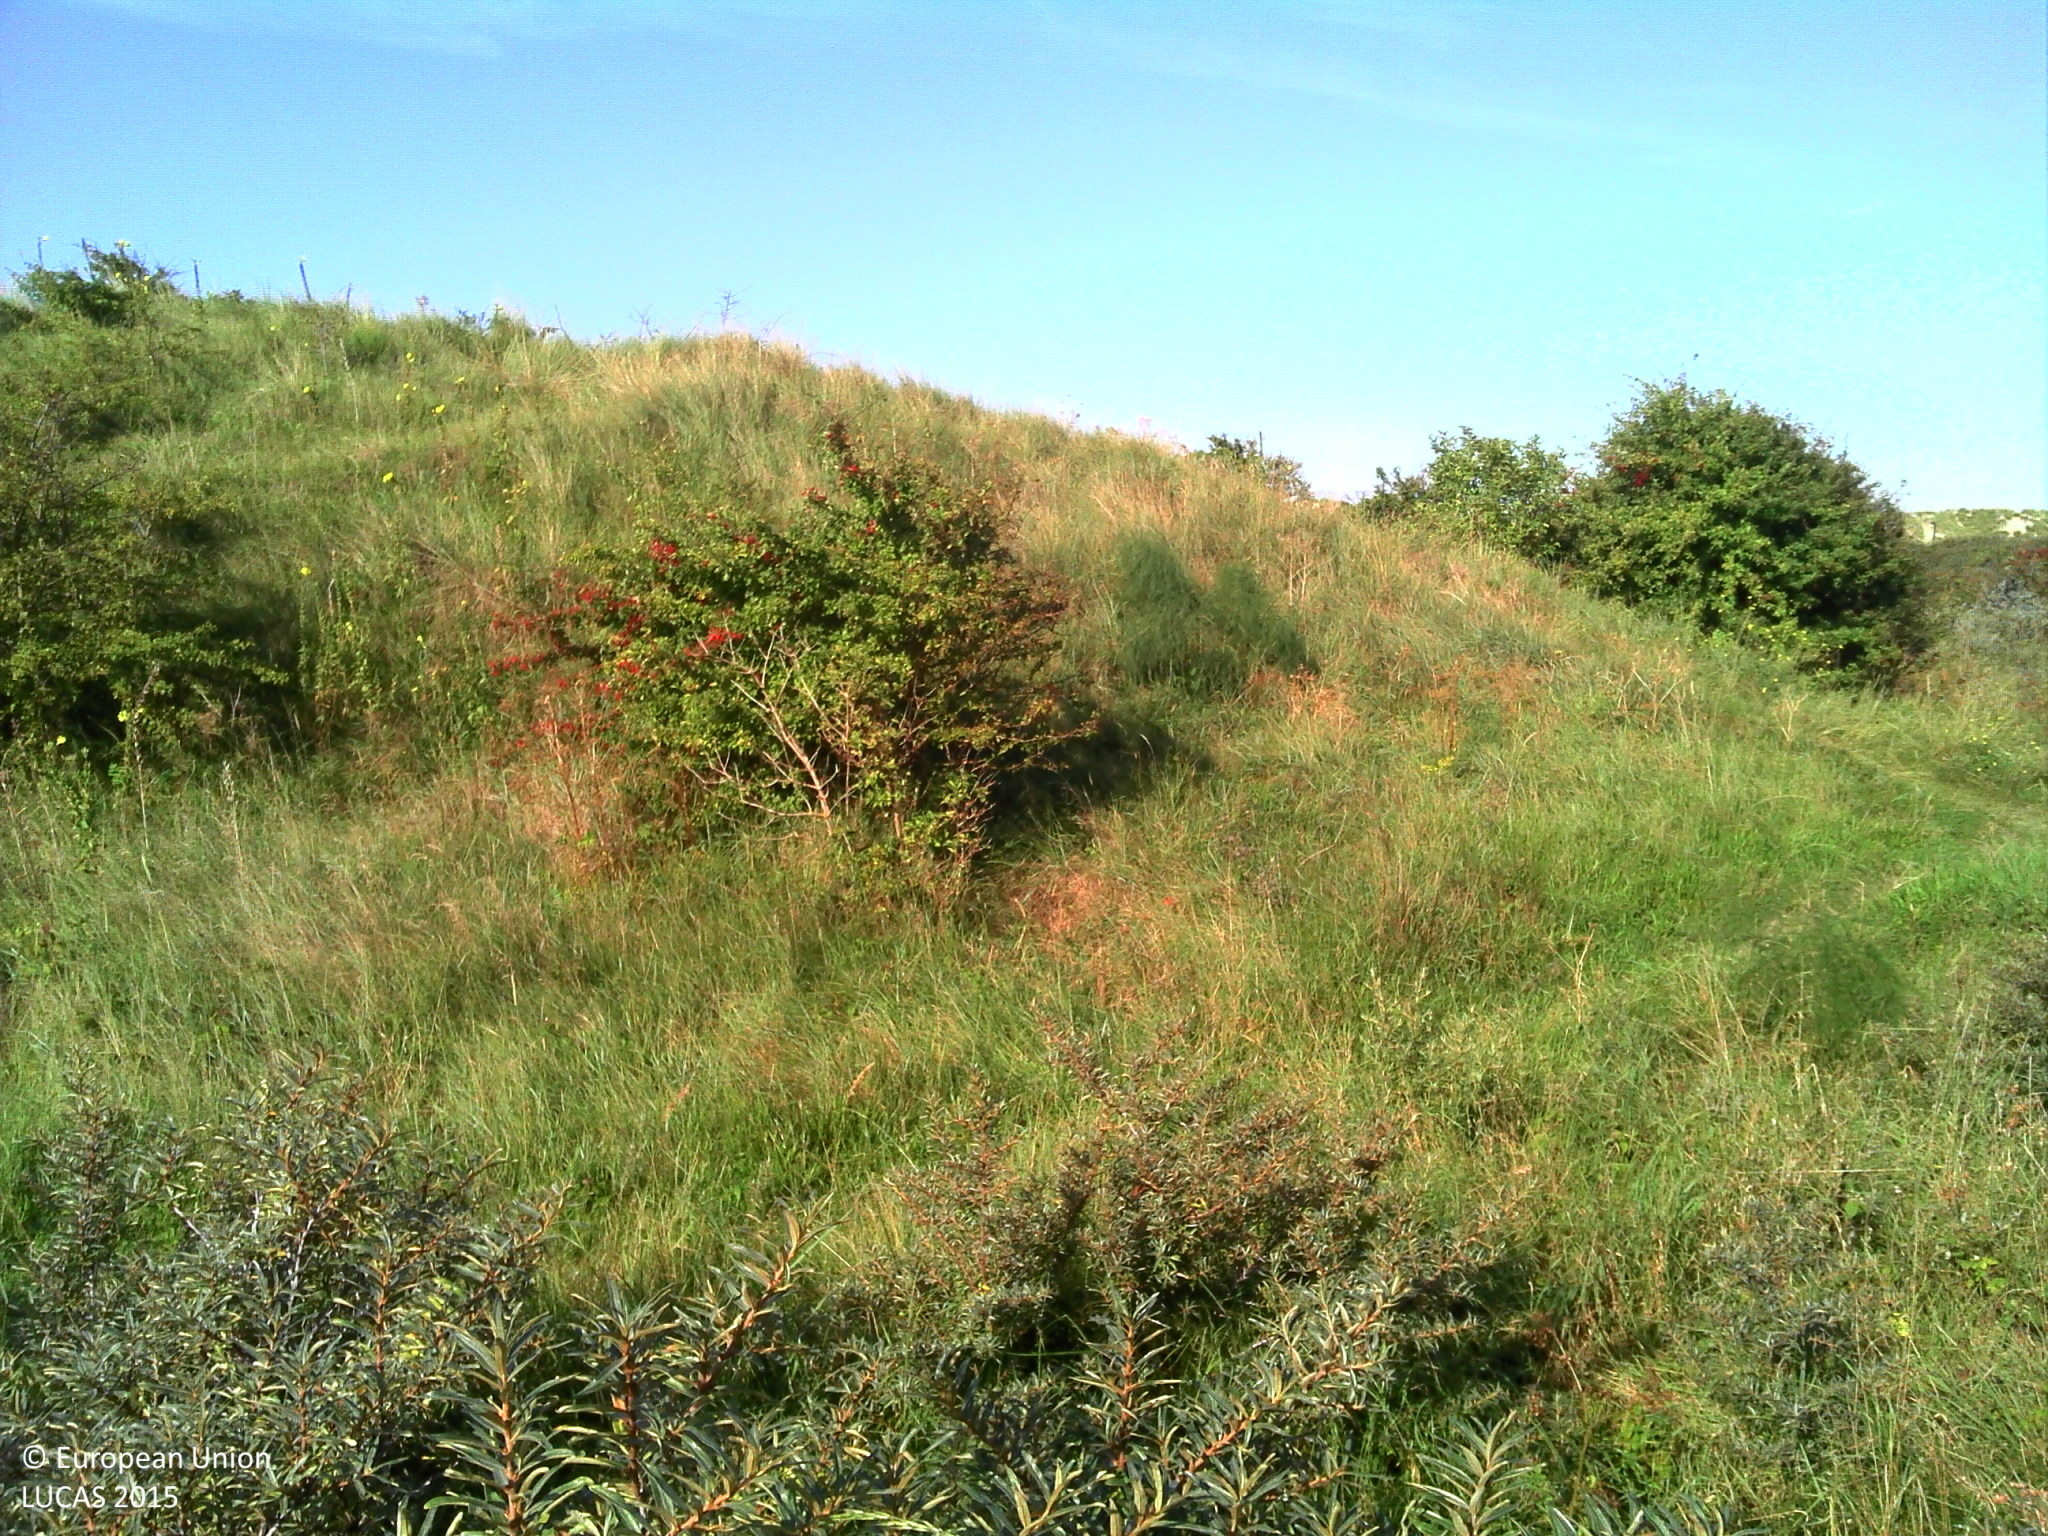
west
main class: Shrubland
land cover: Shrubland without tree cover
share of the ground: > 75 %
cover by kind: shrubs 80 %, herbaceous plants 20 %
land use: Semi-natural and natural areas not in use
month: September
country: BE
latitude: 51.1640
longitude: 2.7670
